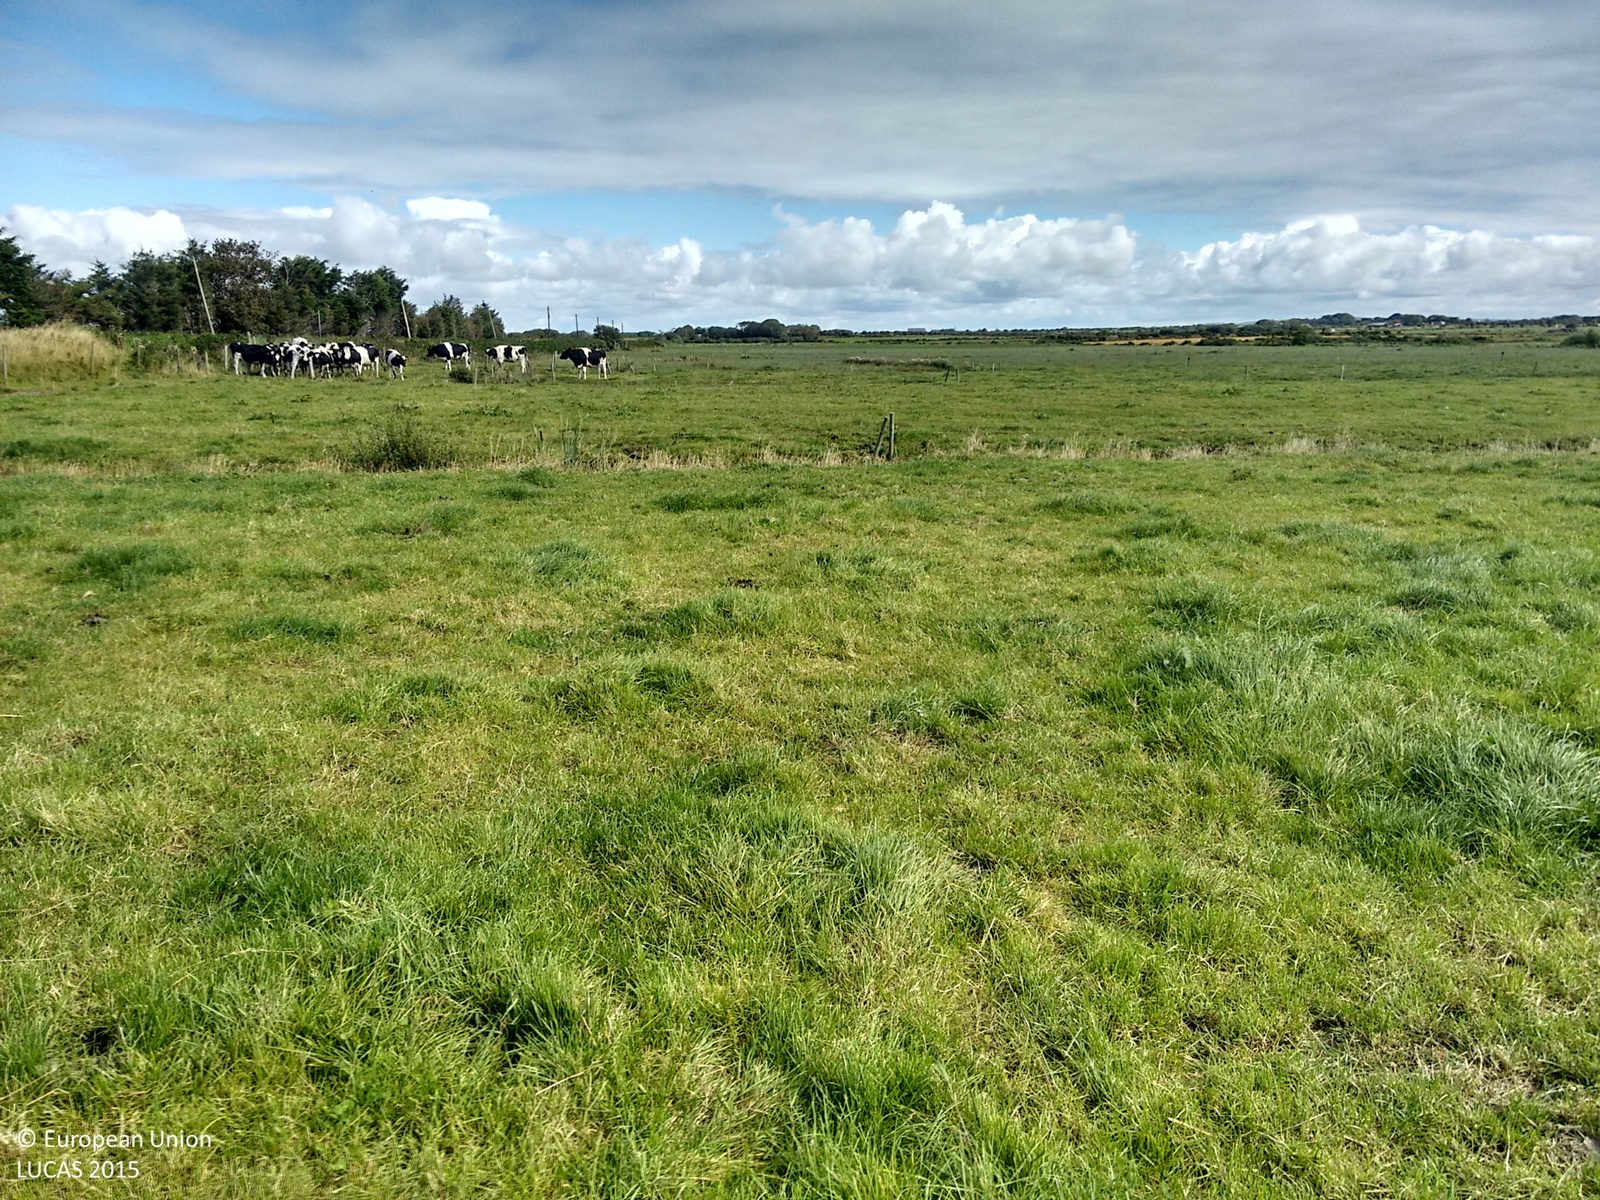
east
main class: Grassland
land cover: Grassland without tree/shrub cover
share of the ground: > 75 %
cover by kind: herbaceous plants 100 %
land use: Agriculture (excluding fallow land and kitchen gardens)
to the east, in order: Grassland without tree/shrub cover; Fences; Ditches and canals; Fences; Grassland without tree/shrub cover; Fences; Ditches and canals; Fences; Grassland without tree/shrub cover; Fences; Ditches and canals; Fences; Grassland without tree/shrub cover; Fences; Ditches and canals; Fences; Grassland without tree/shrub cover
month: September
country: IE
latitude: 52.3950
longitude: -9.7752
